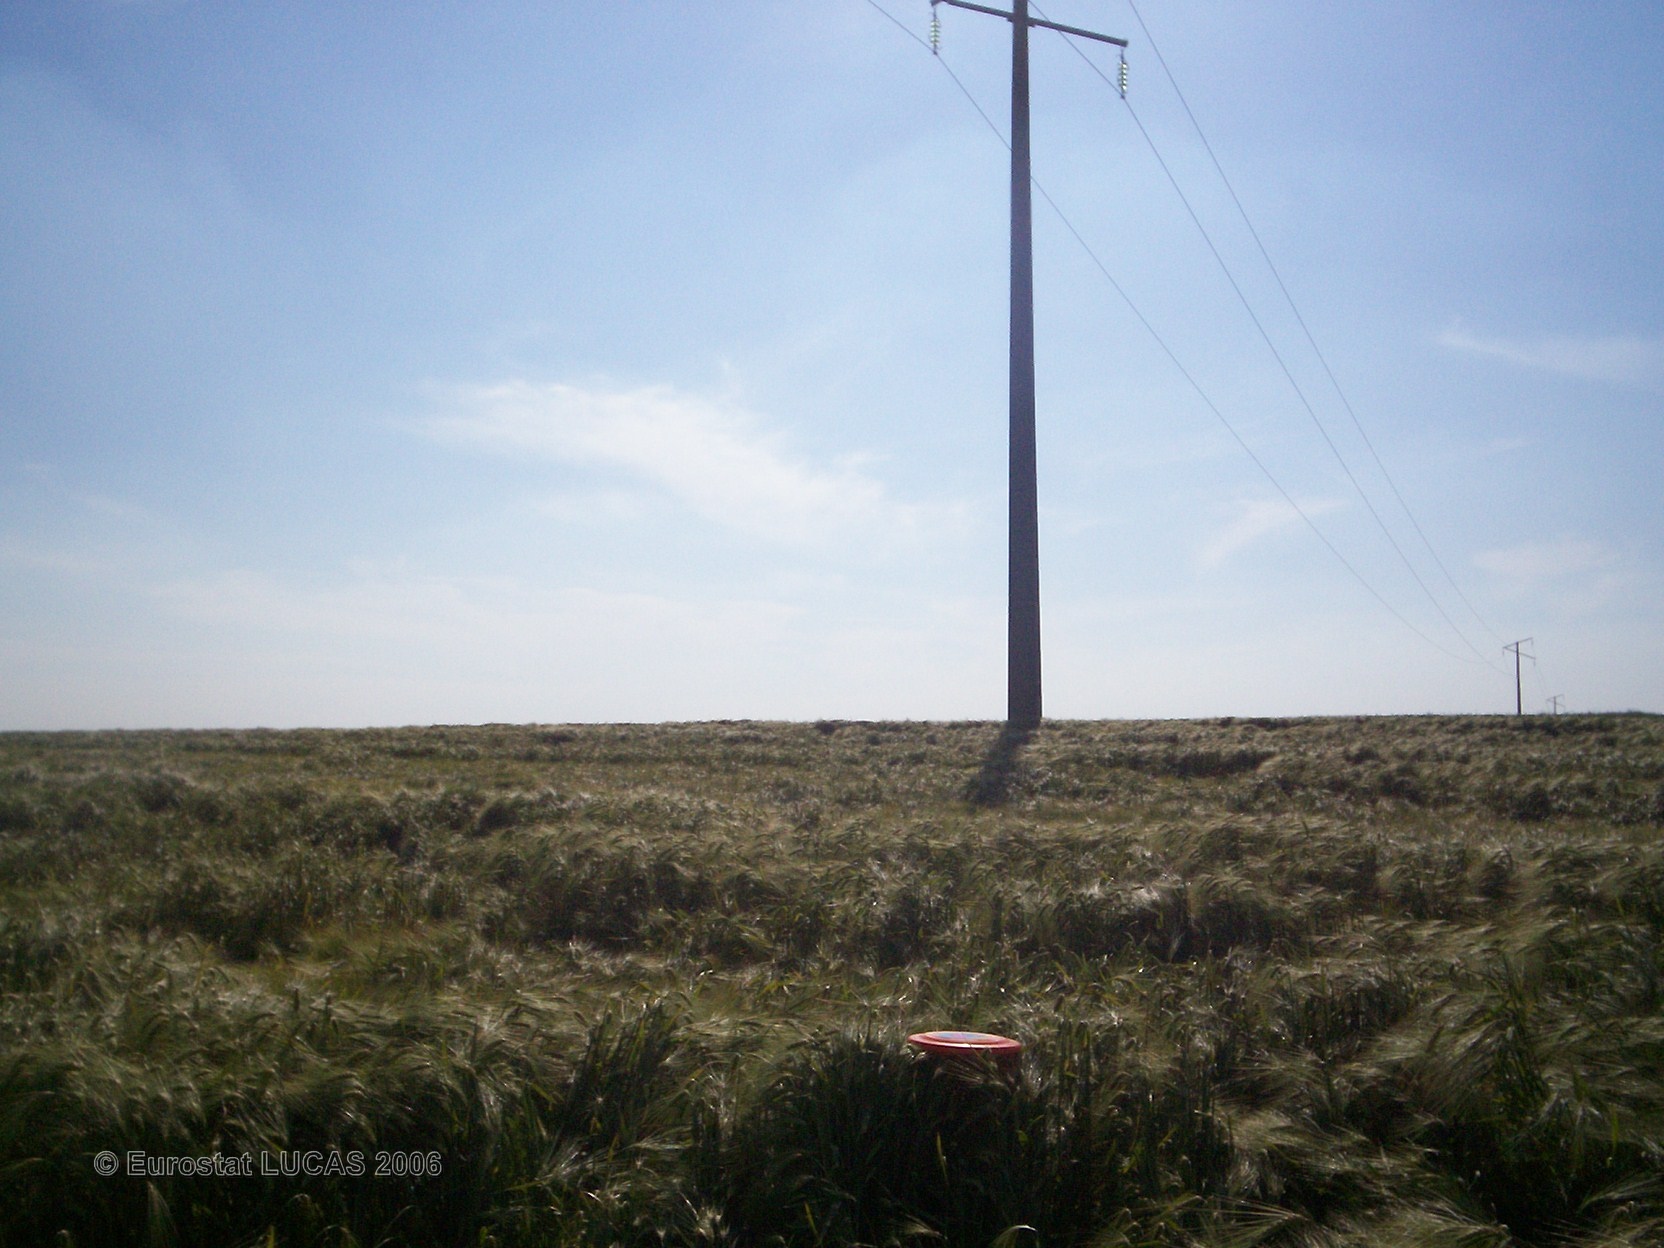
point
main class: Cropland
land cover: Barley
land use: Agriculture (excluding fallow land and kitchen gardens)
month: June
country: FR
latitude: 49.5495
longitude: 2.6493
